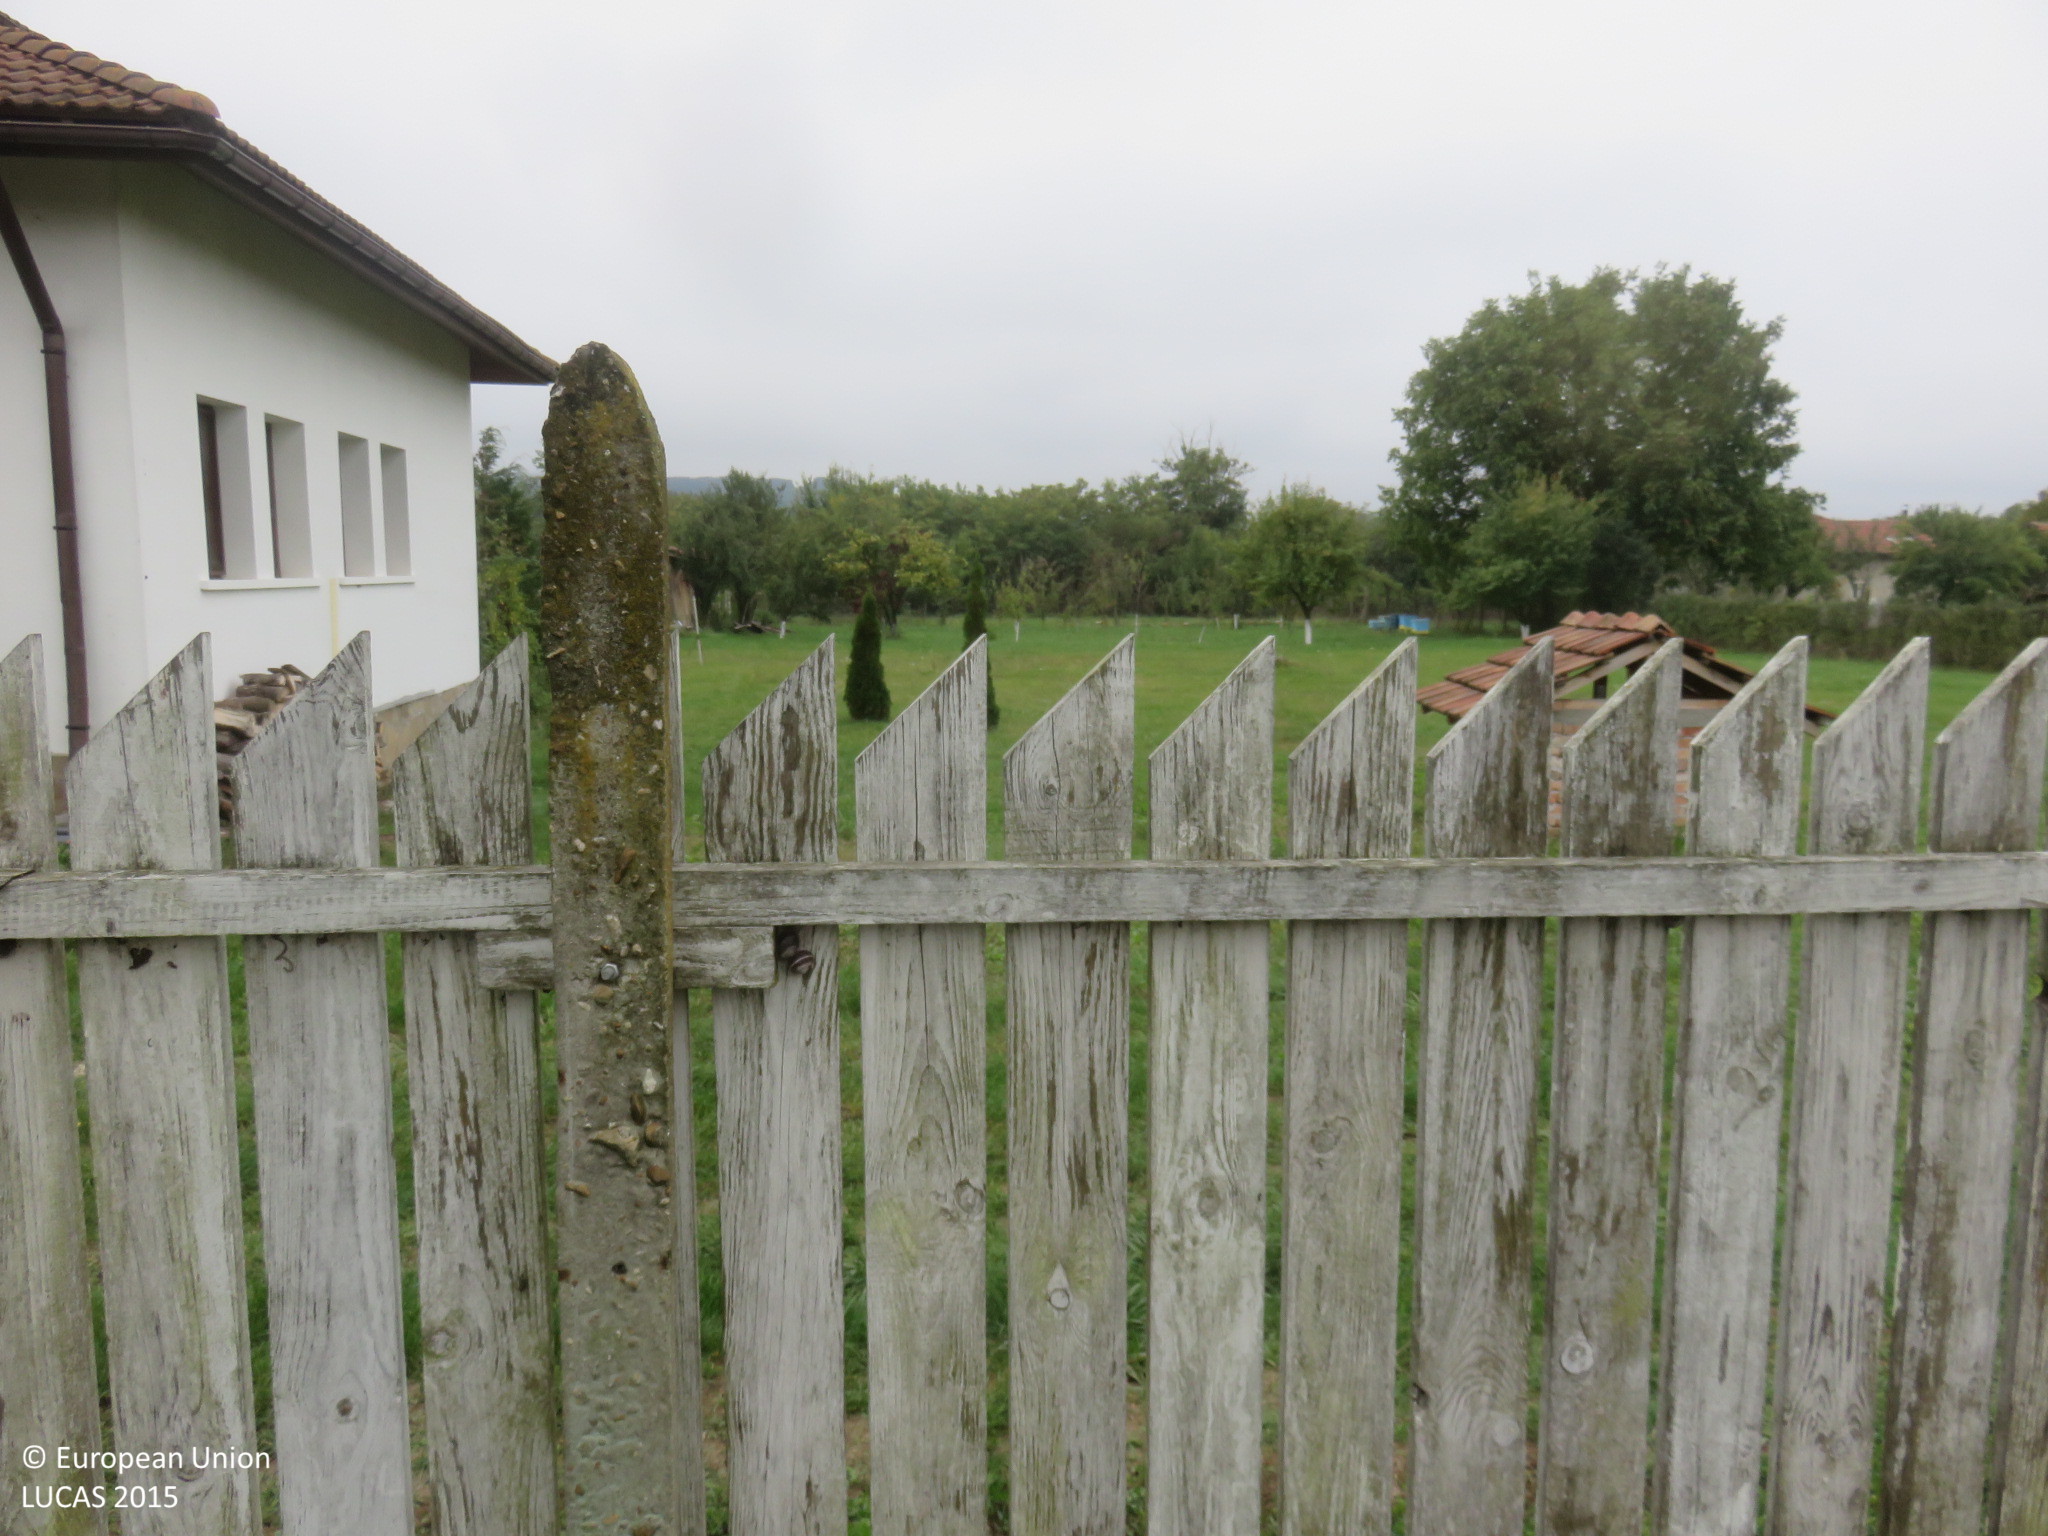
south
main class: Shrubland
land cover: Shrubland with sparse tree cover
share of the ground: > 75 %
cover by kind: shrubs 90 %, broadleaved forest trees 5 %, herbaceous plants 5 %
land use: Abandoned areas
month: October
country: BG
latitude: 43.0286
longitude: 25.1520
